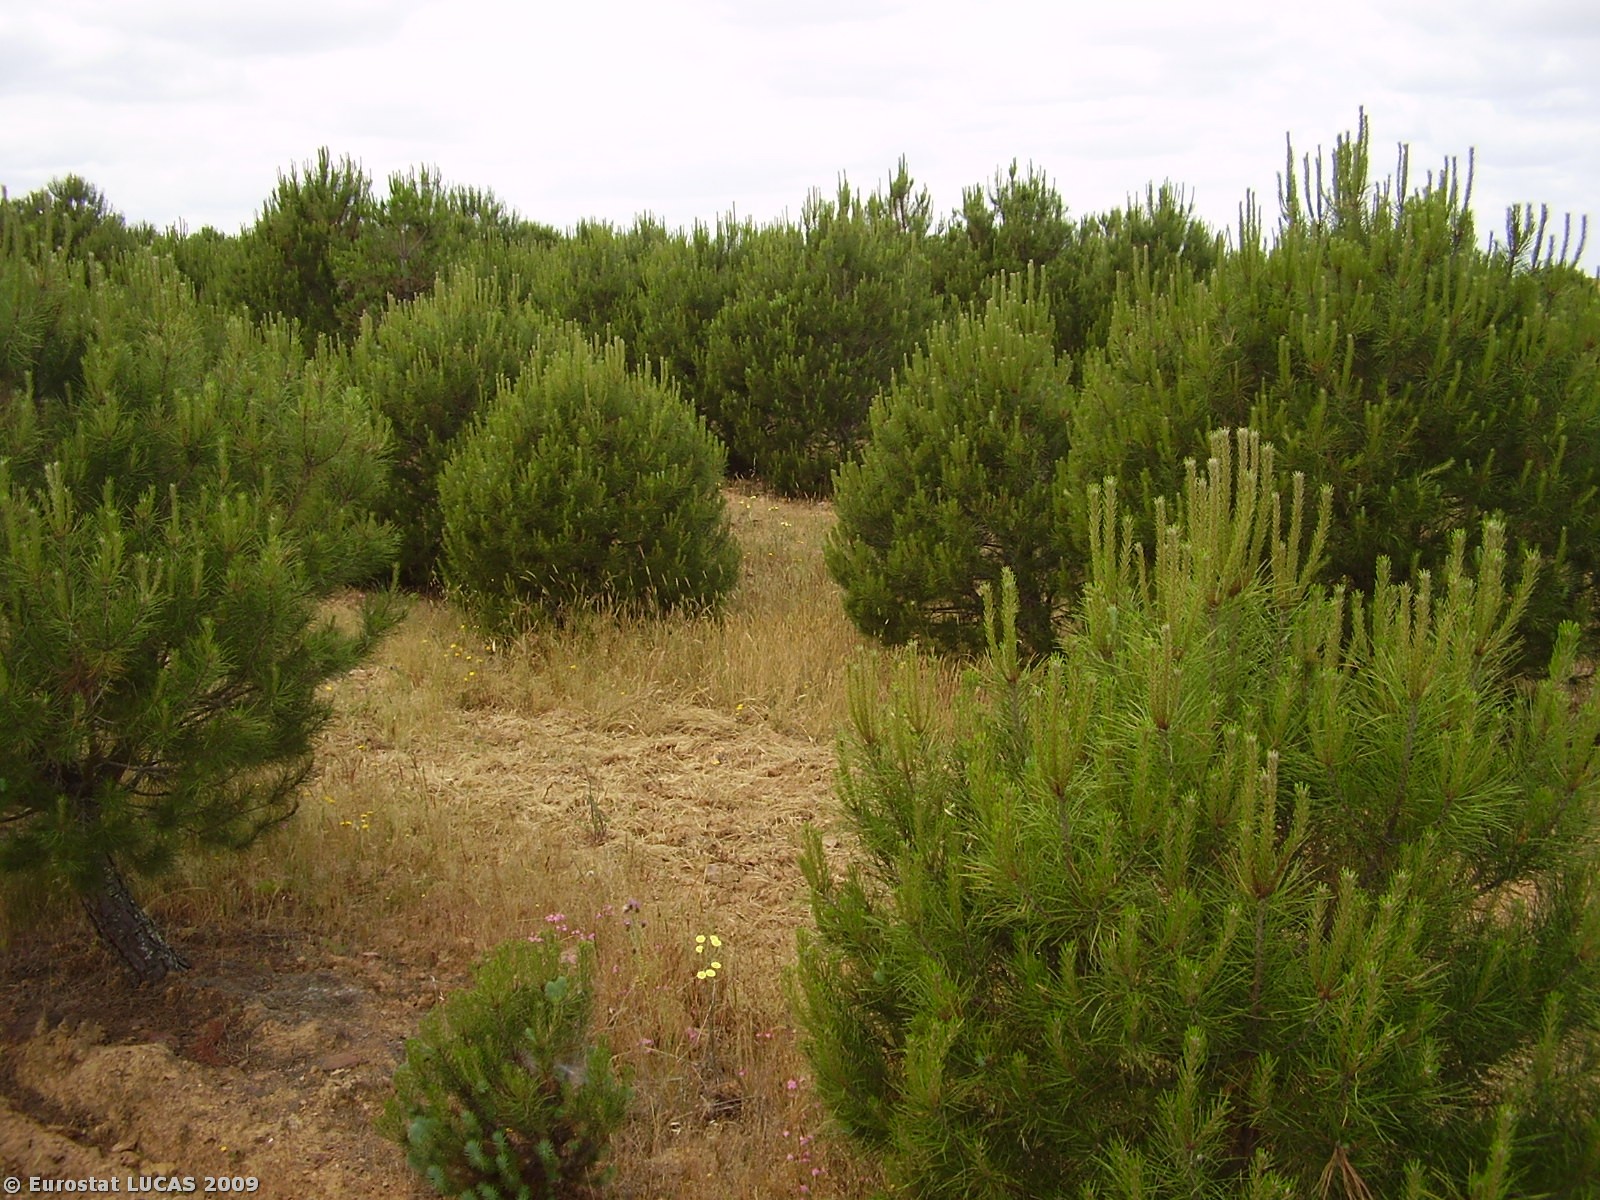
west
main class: Woodland
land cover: Broadleaved woodland
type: broadleaved evergreen forest
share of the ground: 25 - 50 %
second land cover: Spontaneously vegetated surfaces
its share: > 75 %
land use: Forestry
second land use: Fallow land
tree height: > 5 m
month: May
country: PT
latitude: 37.7948
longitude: -7.8874
